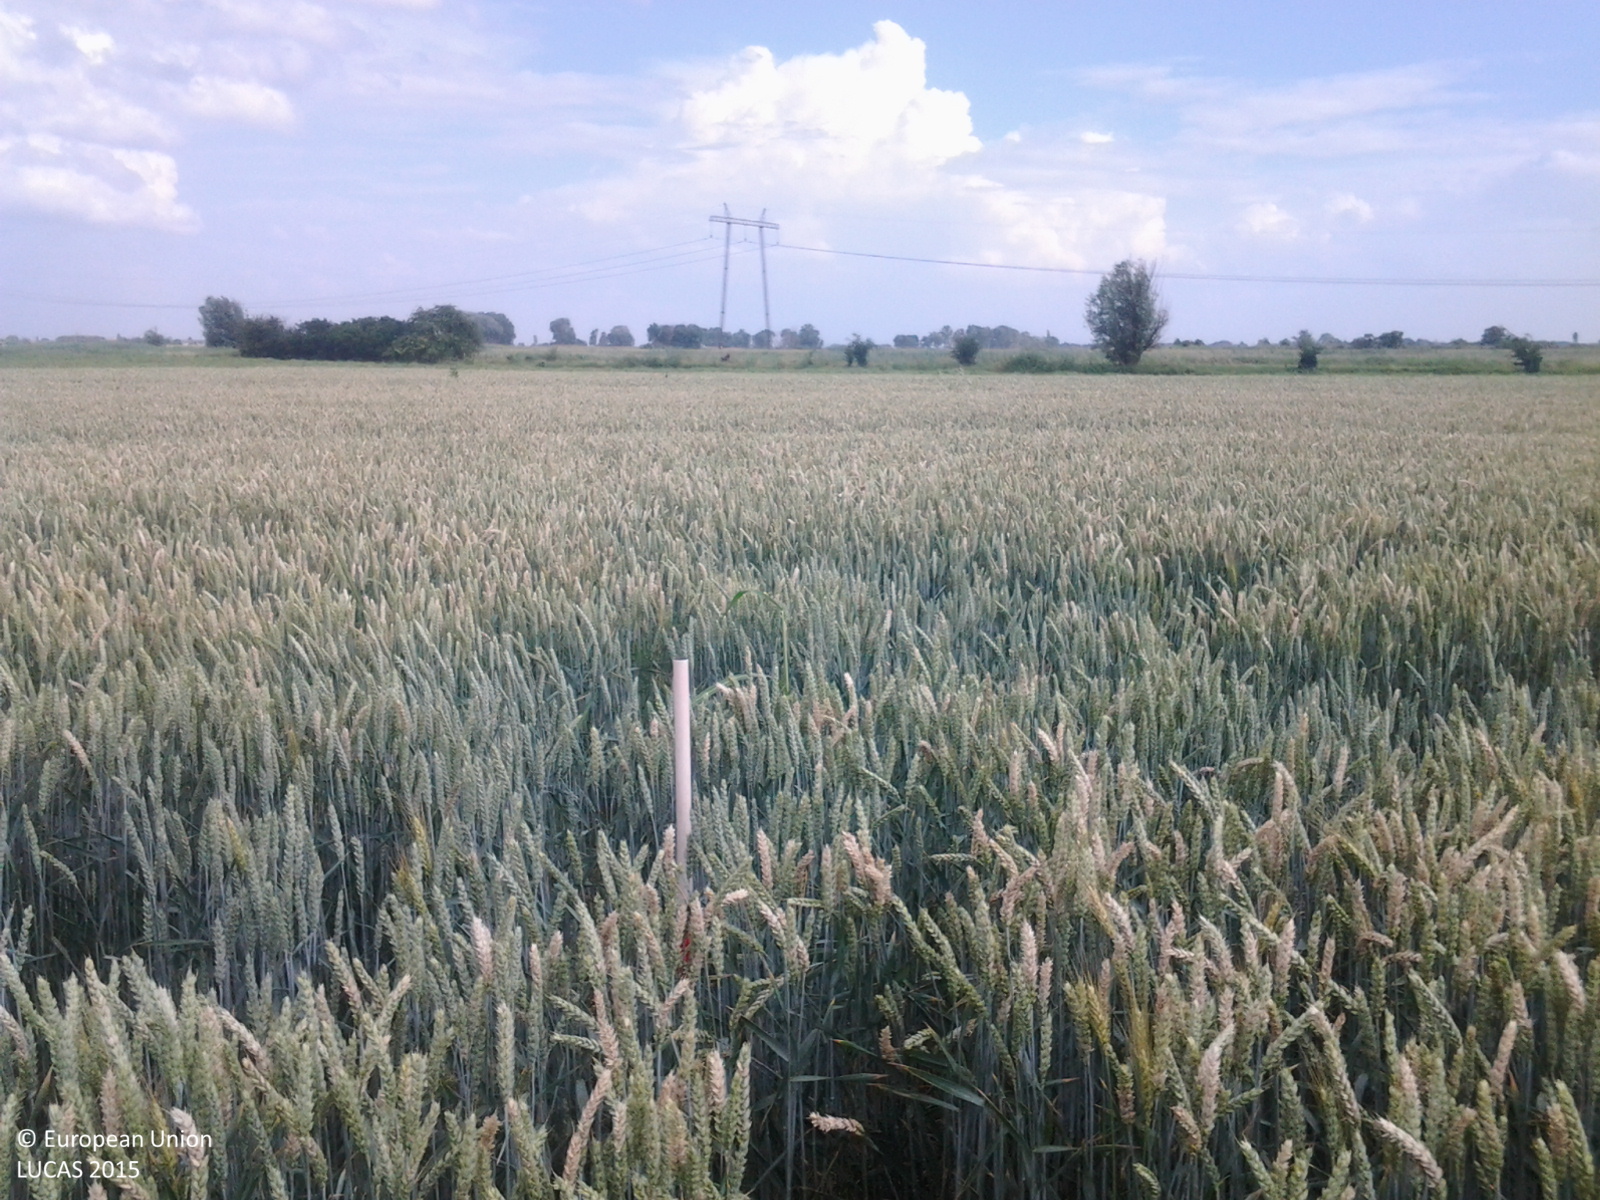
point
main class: Cropland
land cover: Common wheat
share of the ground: > 75 %
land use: Agriculture (excluding fallow land and kitchen gardens)
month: June
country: HU
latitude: 46.4773
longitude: 19.0138
